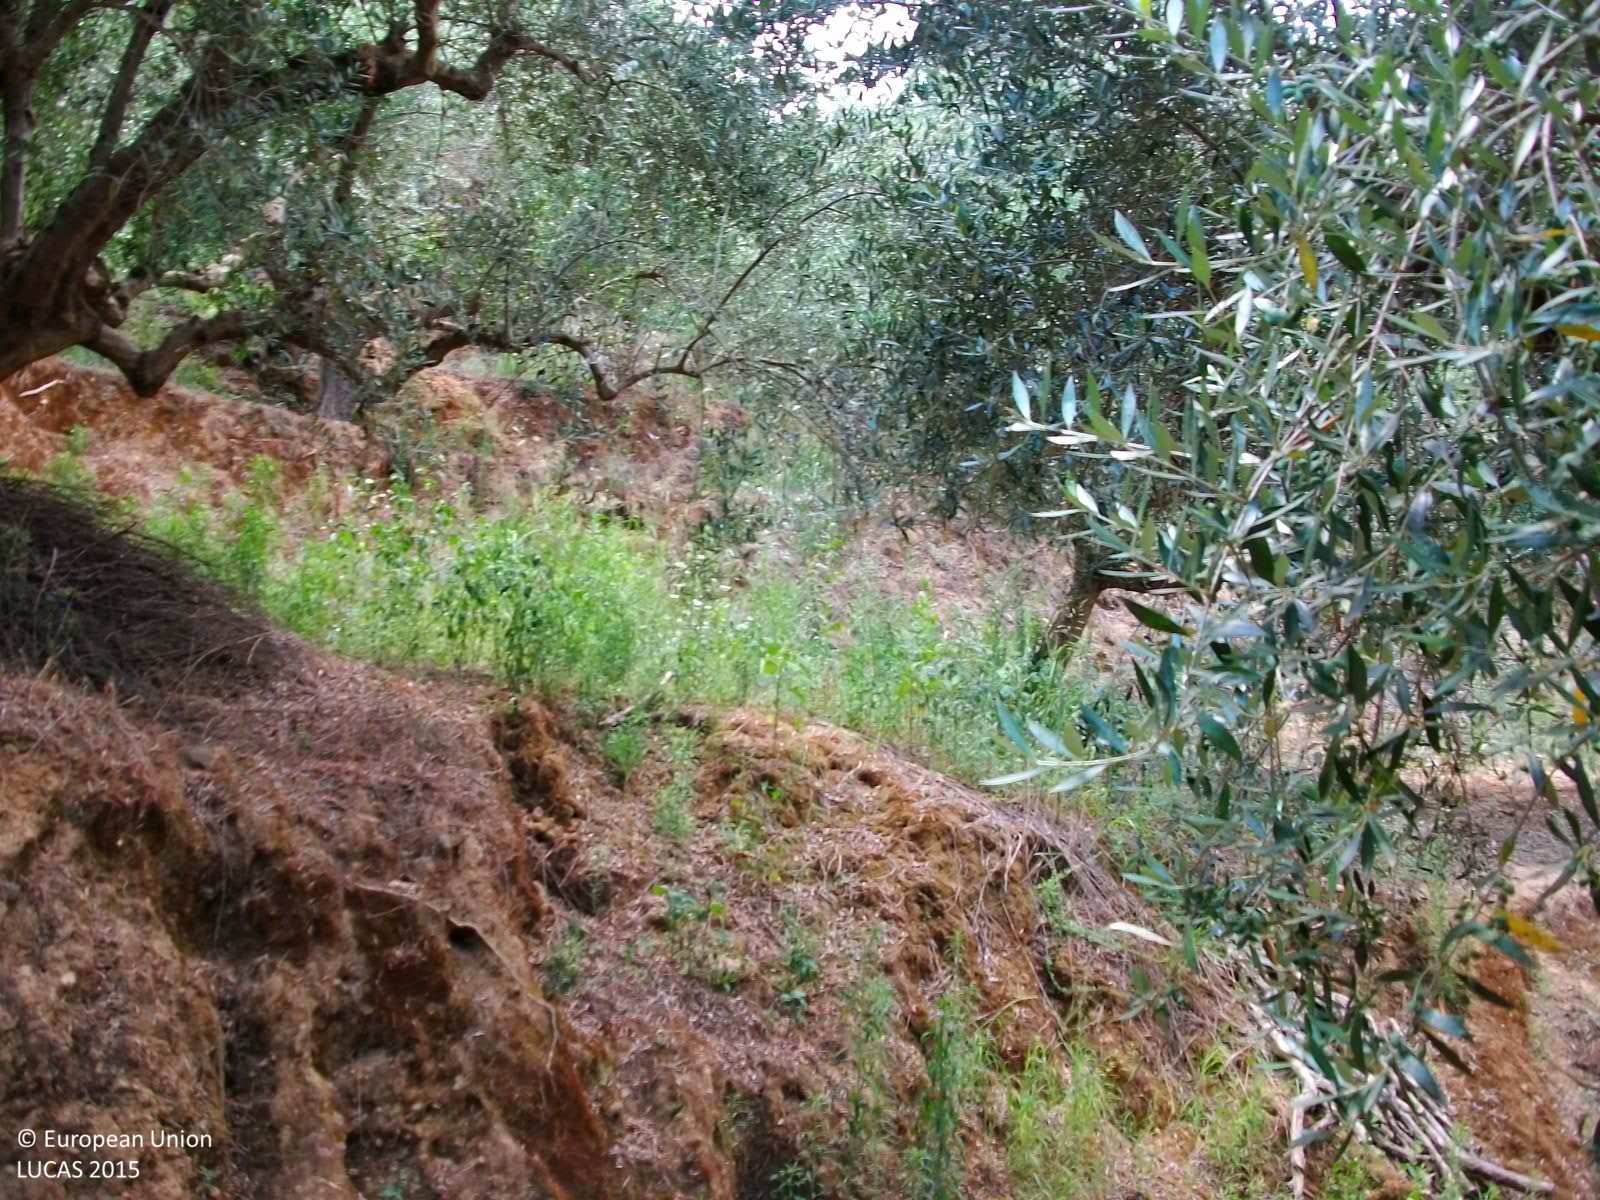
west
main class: Cropland
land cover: Olive groves
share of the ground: 50 - 75 %
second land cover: Spontaneously vegetated surfaces
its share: > 75 %
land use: Agriculture (excluding fallow land and kitchen gardens)
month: July
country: GR
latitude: 37.0819
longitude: 21.9561
